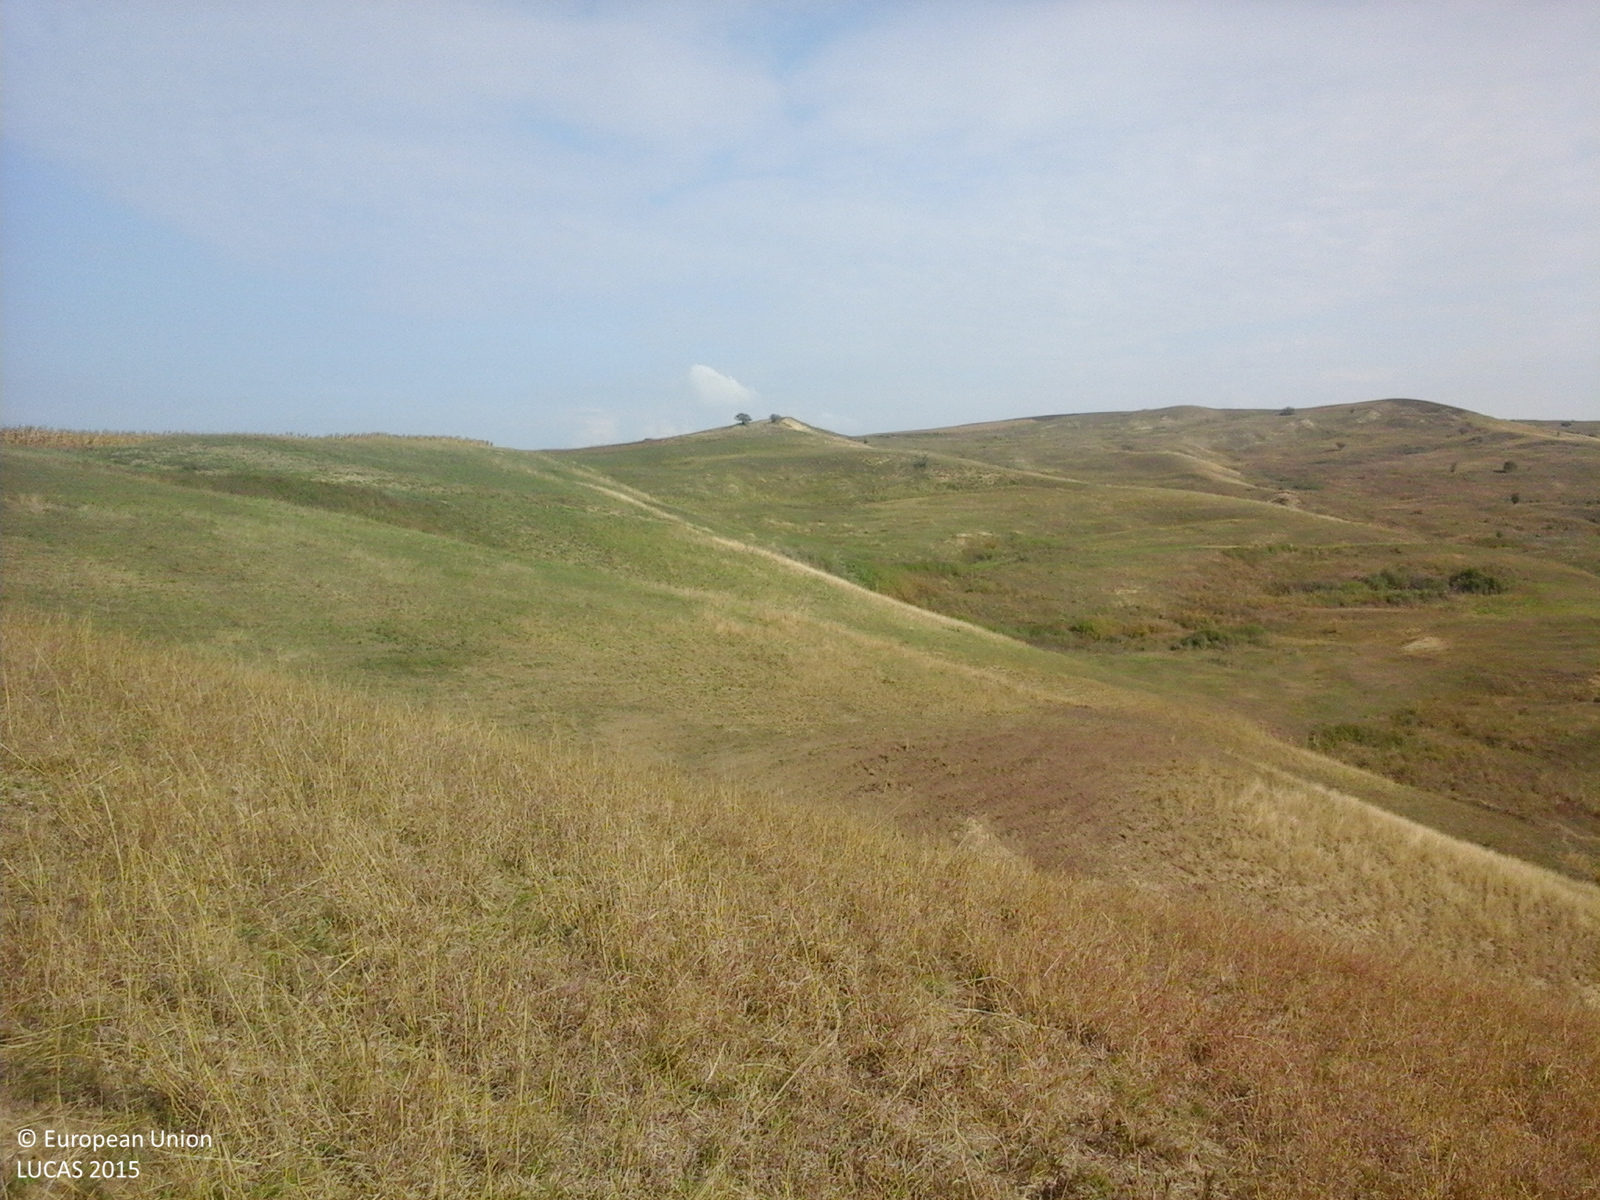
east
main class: Grassland
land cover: Grassland without tree/shrub cover
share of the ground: > 75 %
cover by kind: herbaceous plants 100 %
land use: Agriculture (excluding fallow land and kitchen gardens)
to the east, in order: Grassland without tree/shrub cover; Shrubland without tree cover; Tracks; Shrubland without tree cover; Grassland without tree/shrub cover
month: October
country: RO
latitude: 46.2935
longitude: 23.9250
